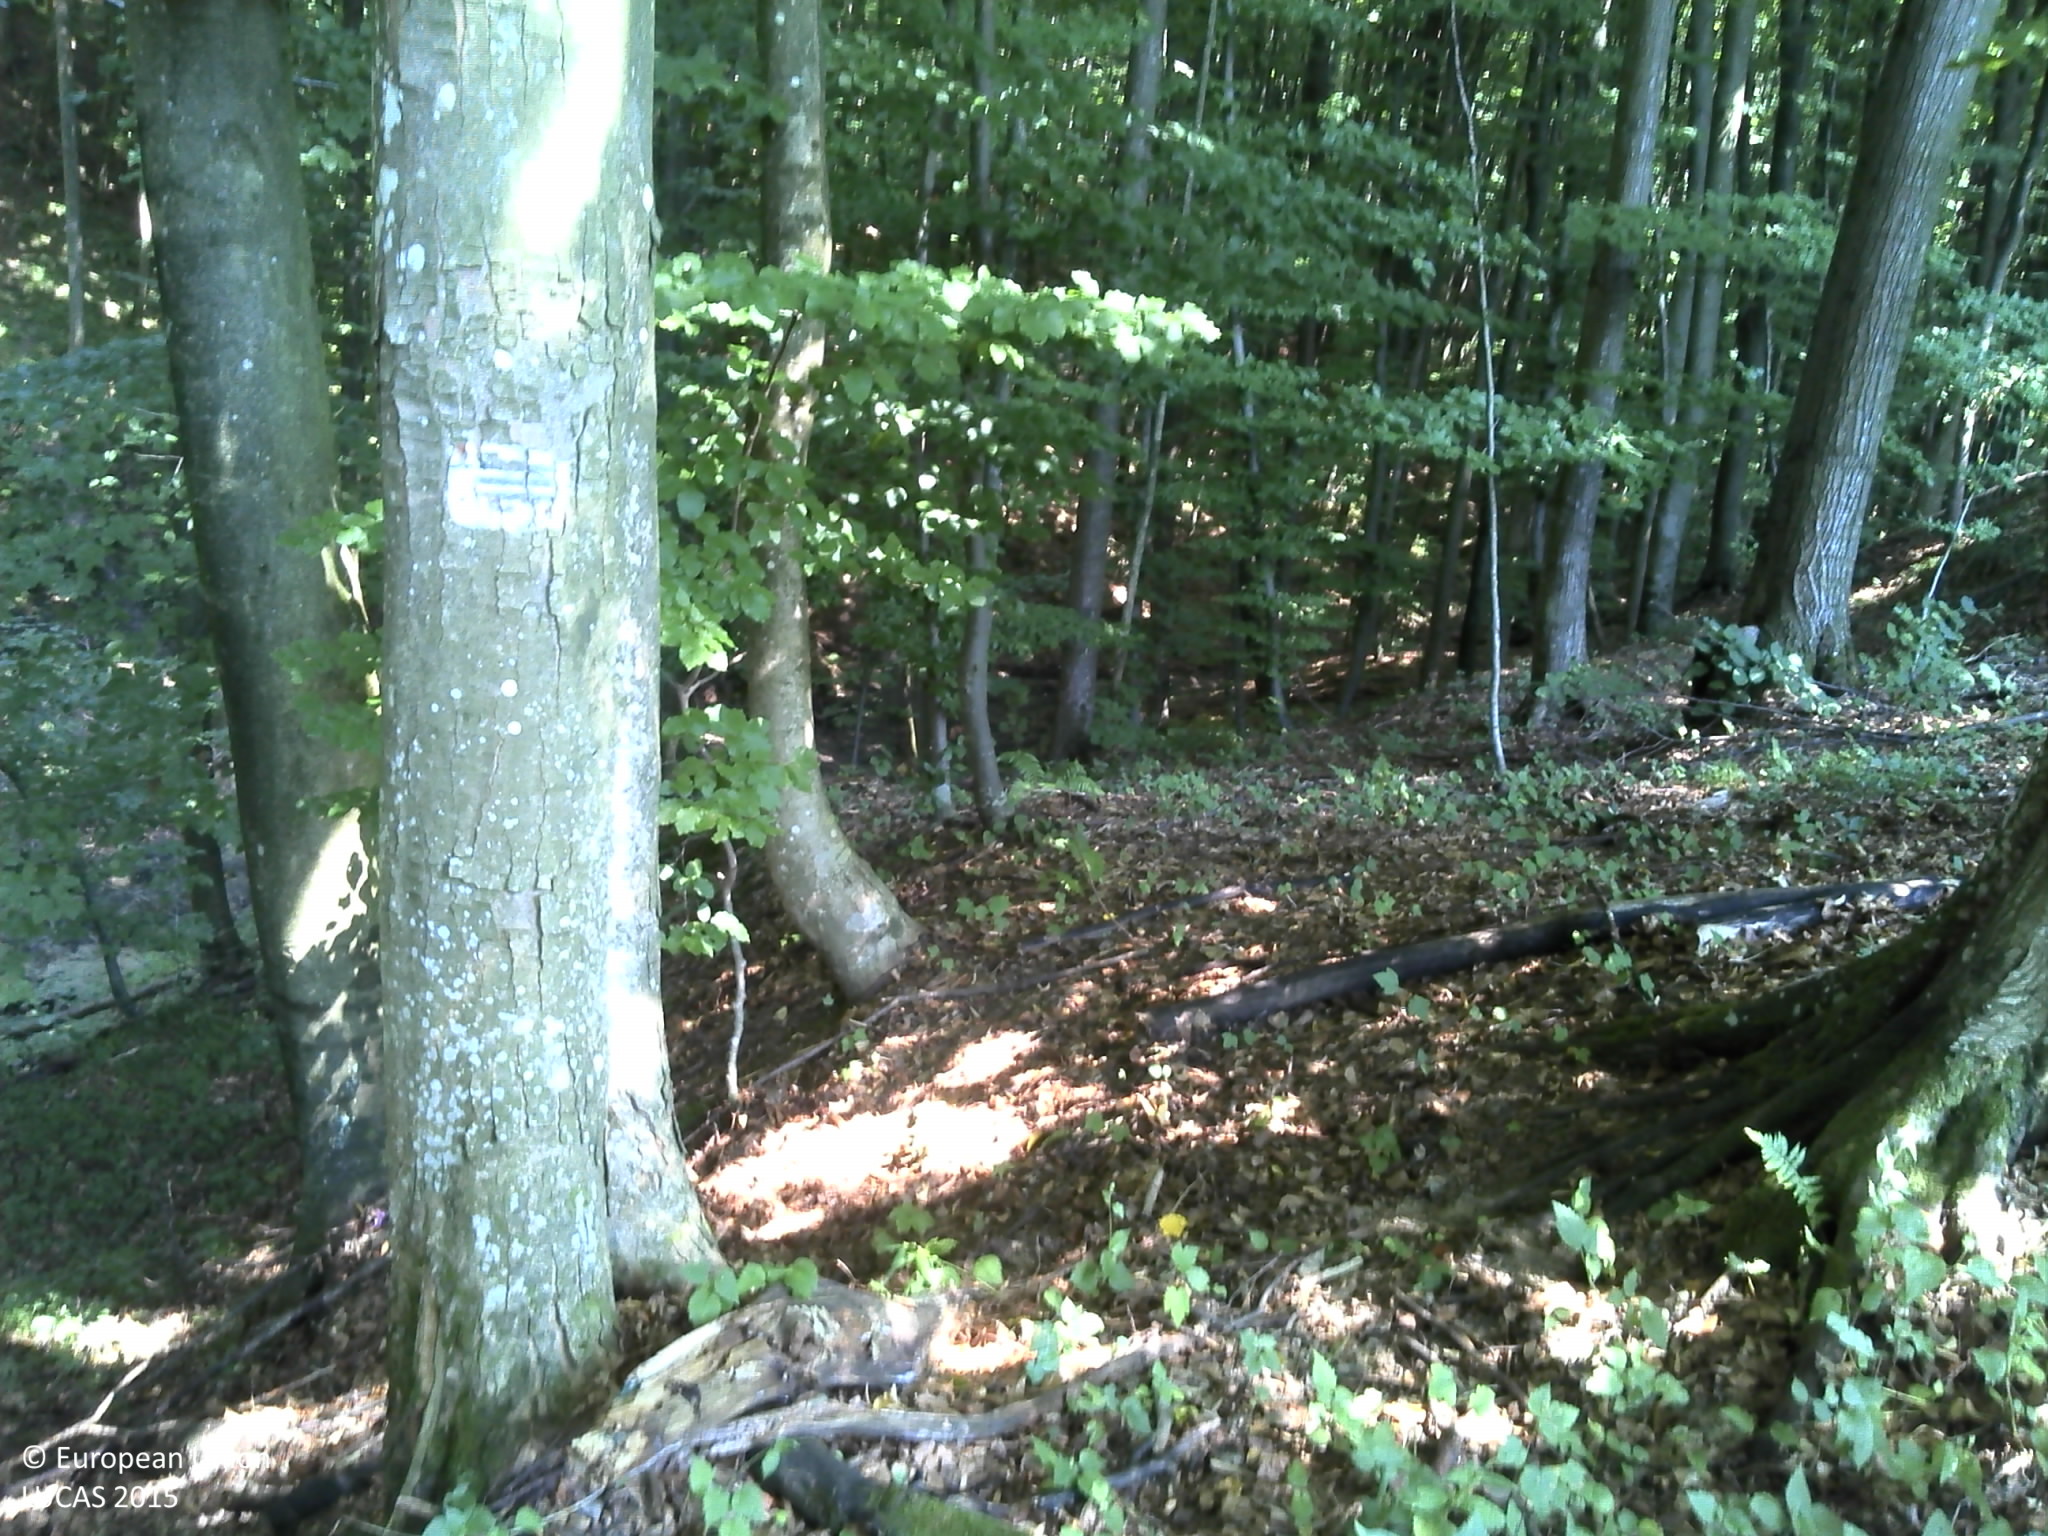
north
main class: Woodland
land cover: Broadleaved woodland
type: beech forest
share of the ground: > 75 %
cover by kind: broadleaved forest trees 100 %
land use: Forestry
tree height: > 5 m
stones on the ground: < 10 %
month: August
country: HR
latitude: 45.7639
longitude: 17.2146
